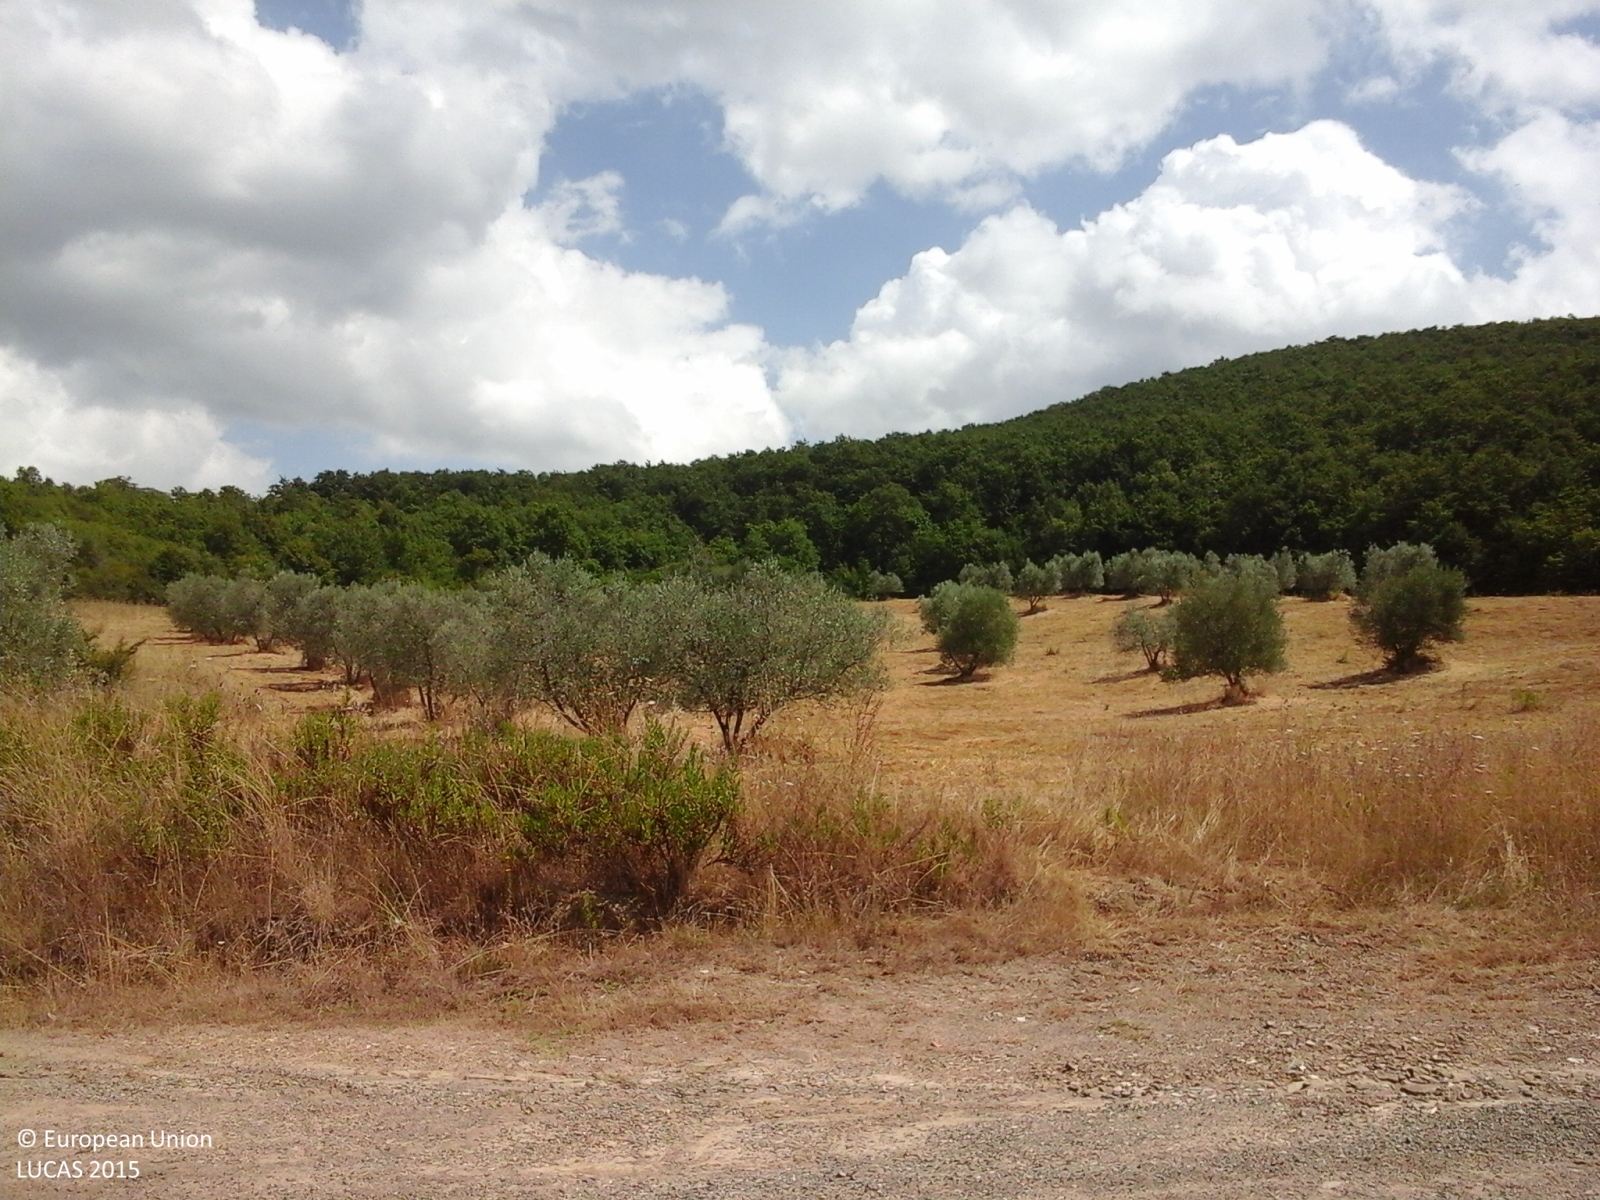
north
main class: Grassland
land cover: Grassland with sparse tree/shrub cover
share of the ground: > 75 %
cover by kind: herbaceous plants 85 %, shrubs 10 %, broadleaved forest trees 5 %
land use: Agriculture (excluding fallow land and kitchen gardens)
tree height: < 5 m
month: February
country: IT
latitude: 43.4443
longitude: 10.9241
